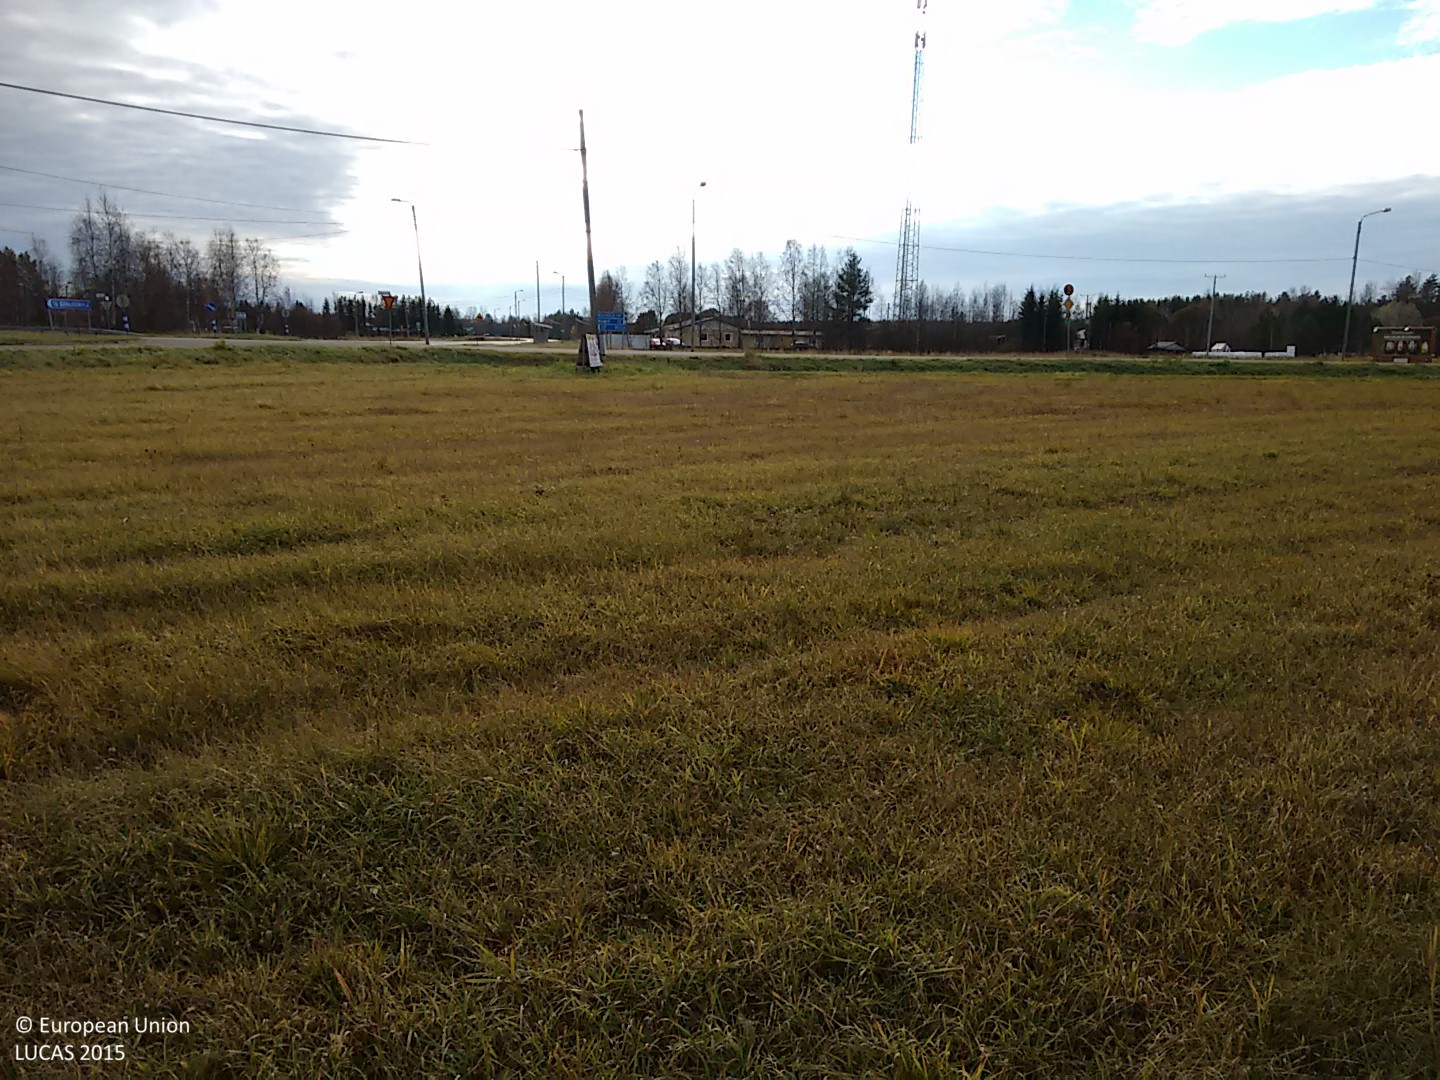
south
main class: Grassland
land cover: Grassland without tree/shrub cover
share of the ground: > 75 %
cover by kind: herbaceous plants 100 %
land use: Agriculture (excluding fallow land and kitchen gardens)
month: October
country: FI
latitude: 64.7176
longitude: 24.9543
